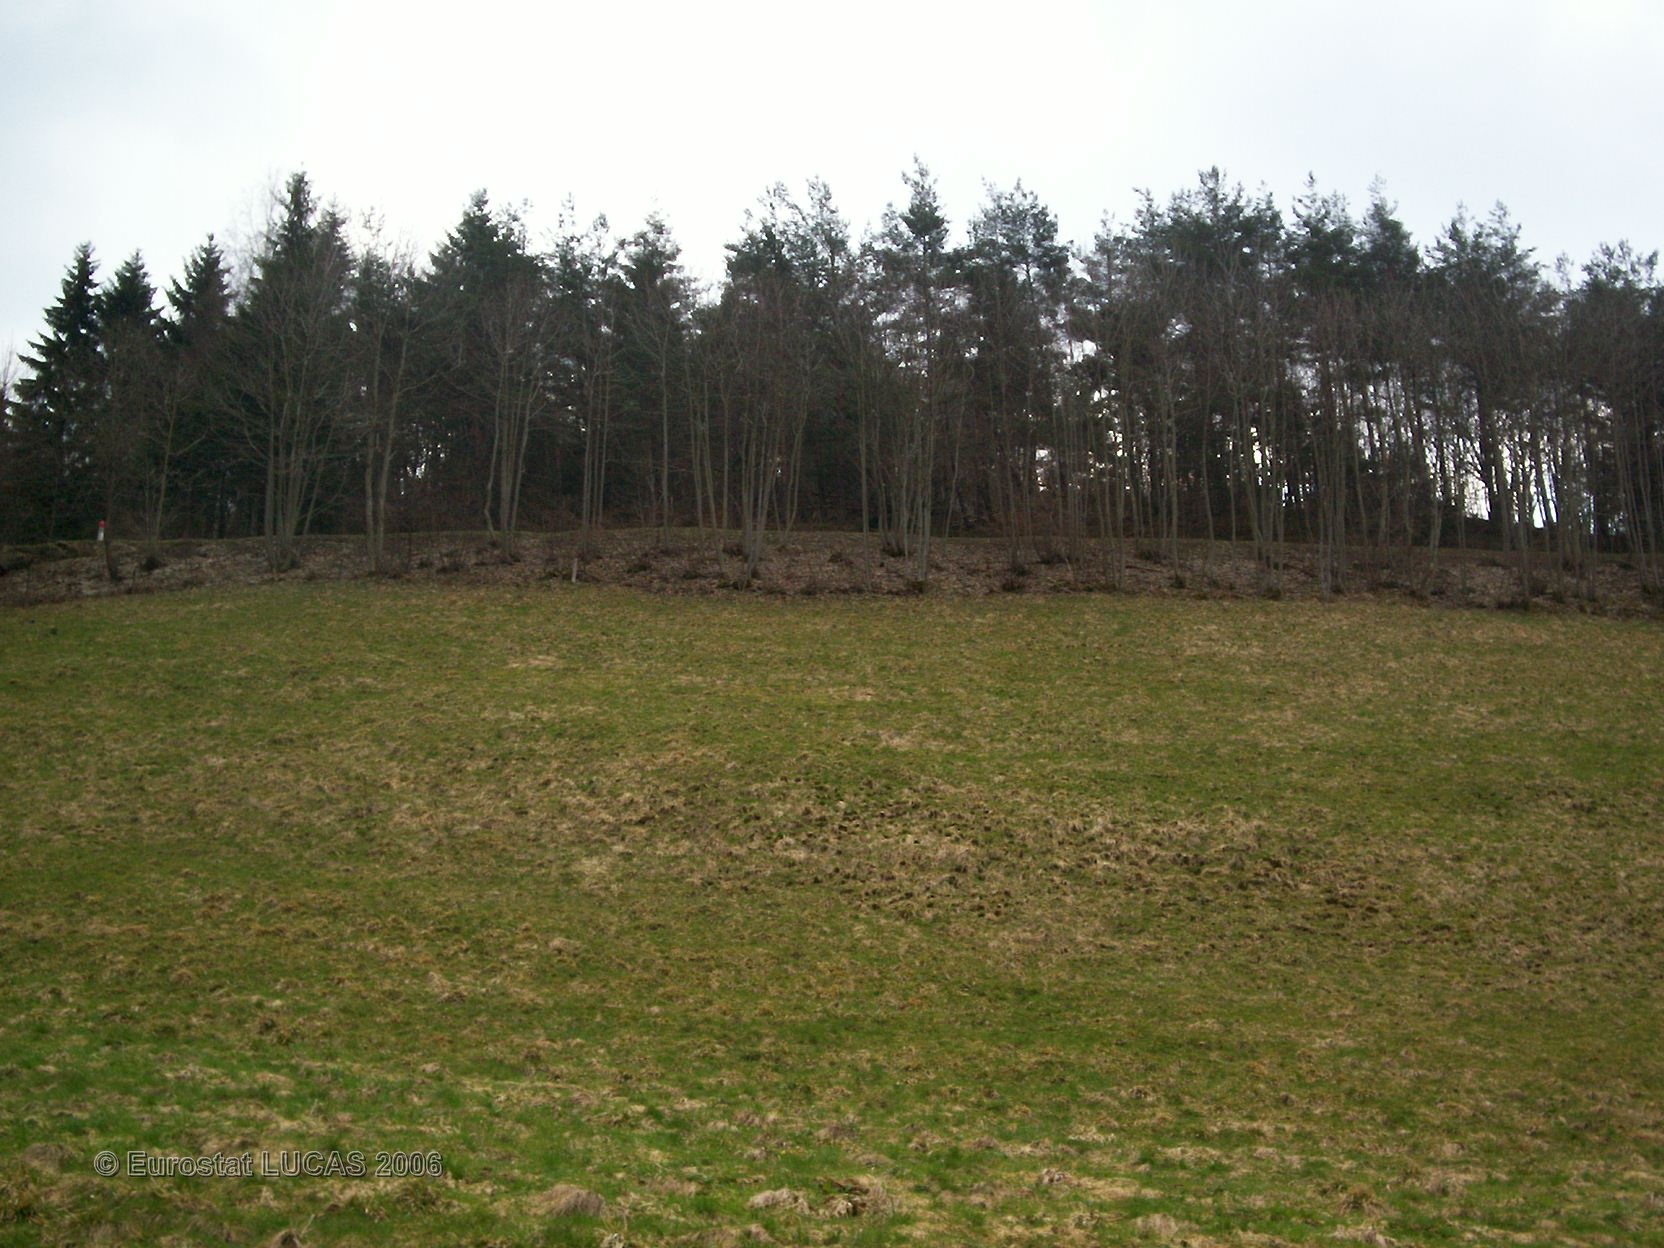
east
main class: Grassland
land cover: Grassland without tree/shrub cover
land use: Agriculture (excluding fallow land and kitchen gardens)
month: April
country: FR
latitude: 48.1857
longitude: 7.1091
